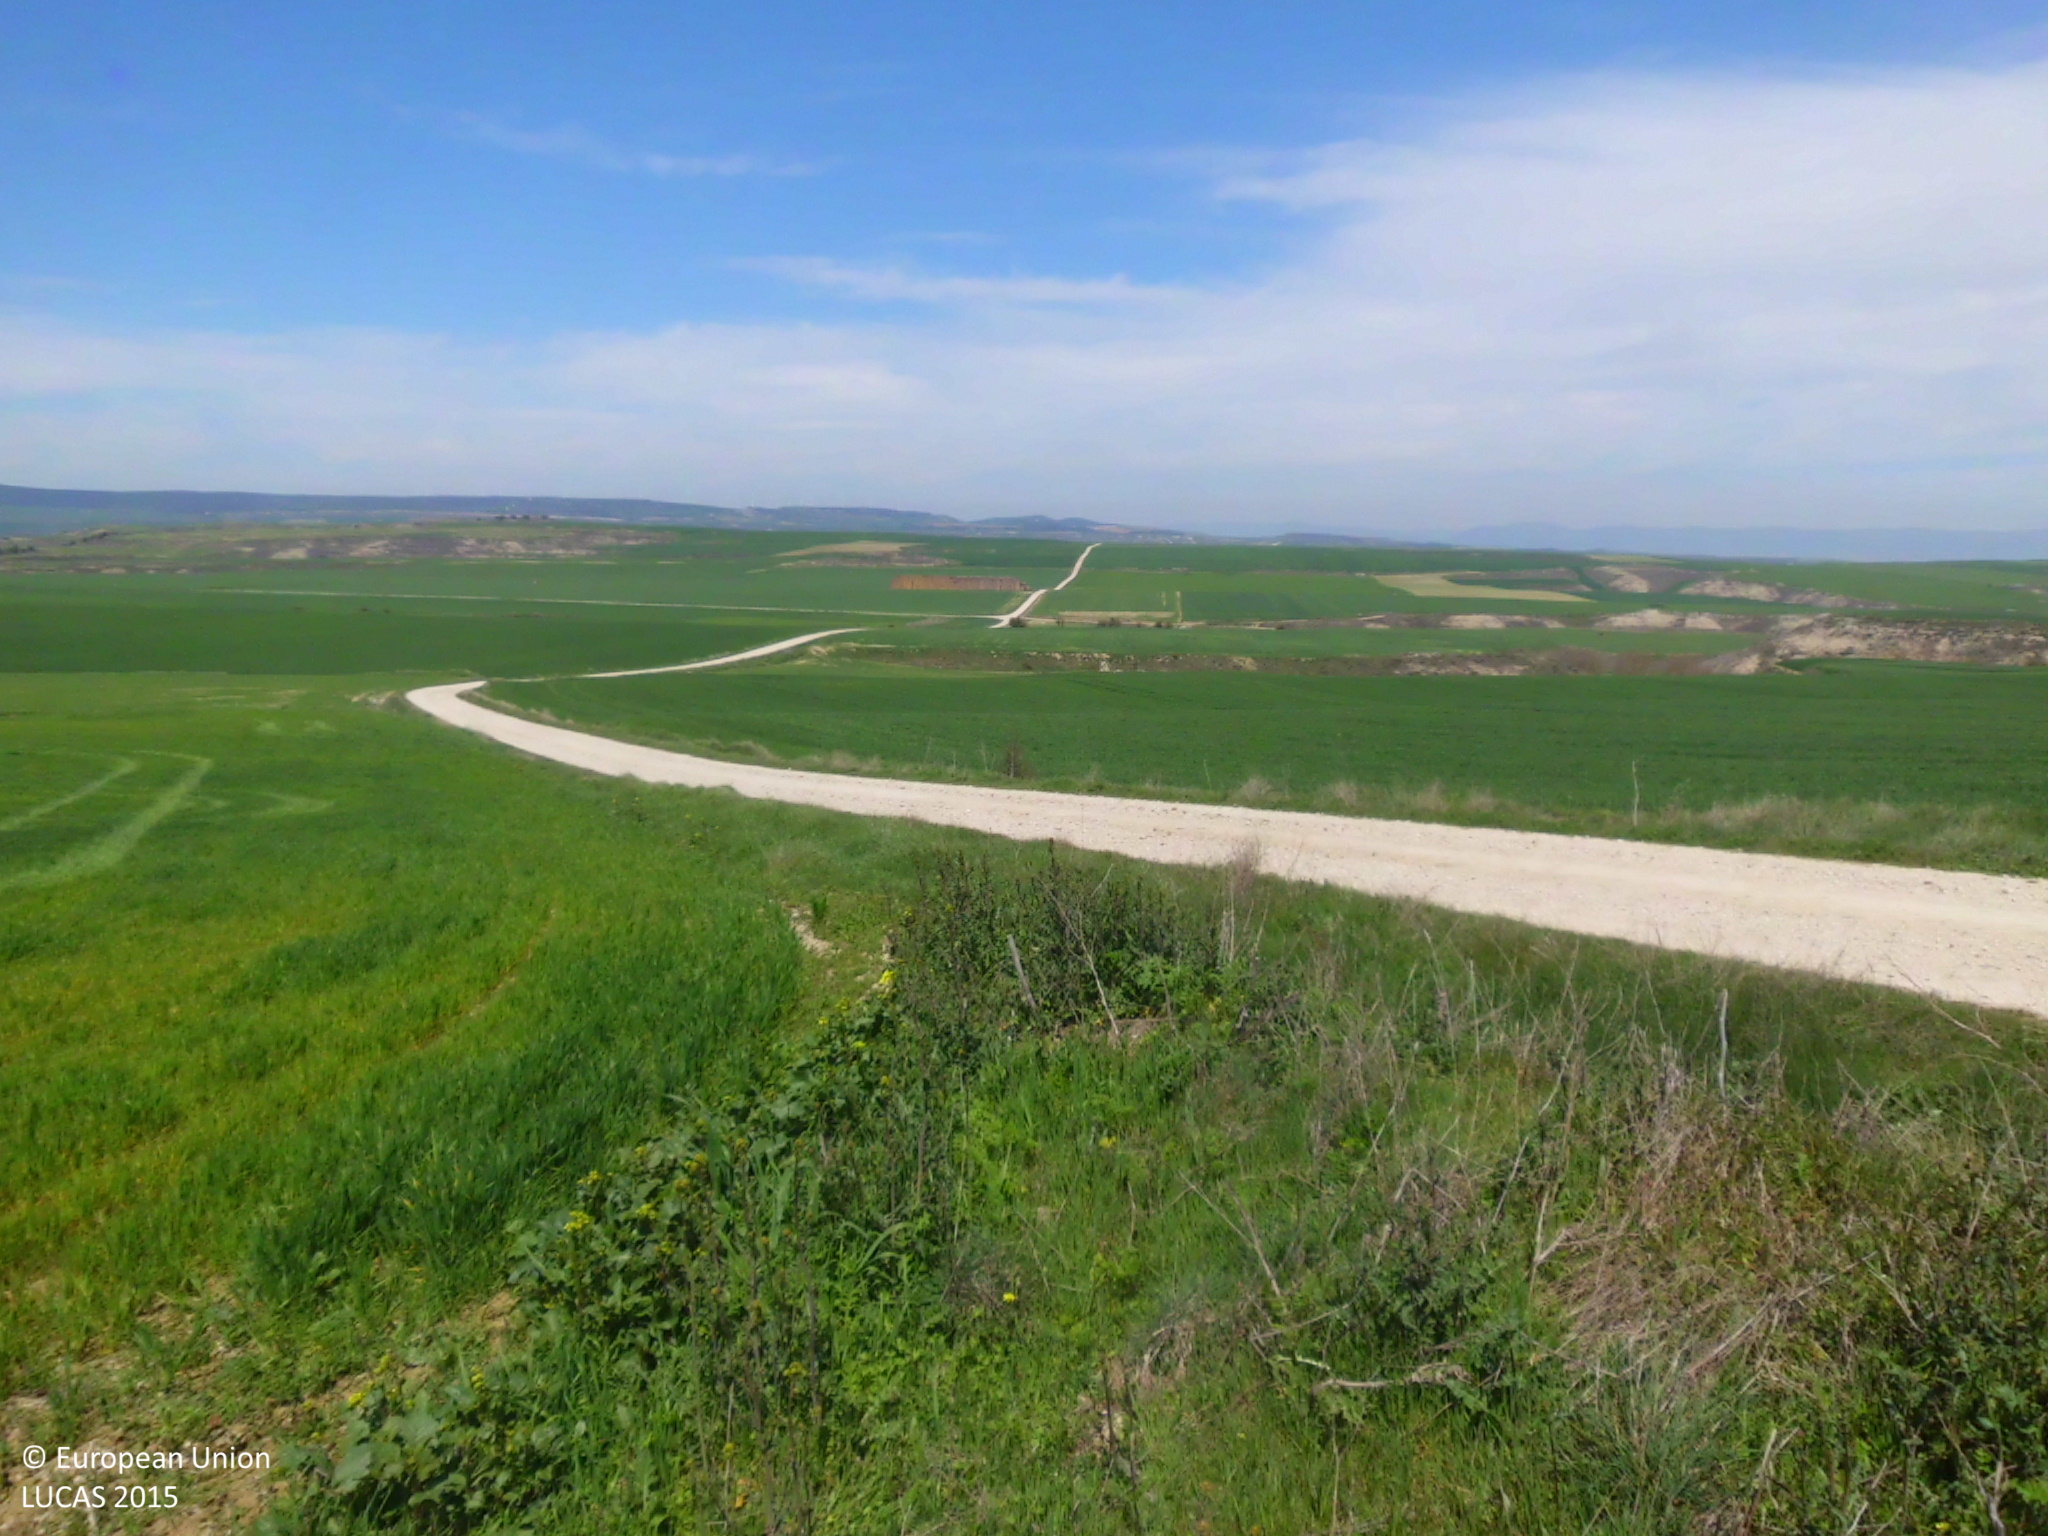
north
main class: Grassland
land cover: Grassland with sparse tree/shrub cover
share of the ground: > 75 %
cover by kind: herbaceous plants 90 %, broadleaved forest trees 5 %, shrubs 5 %
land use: Abandoned areas
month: April
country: ES
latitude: 42.4639
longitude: -3.3245
